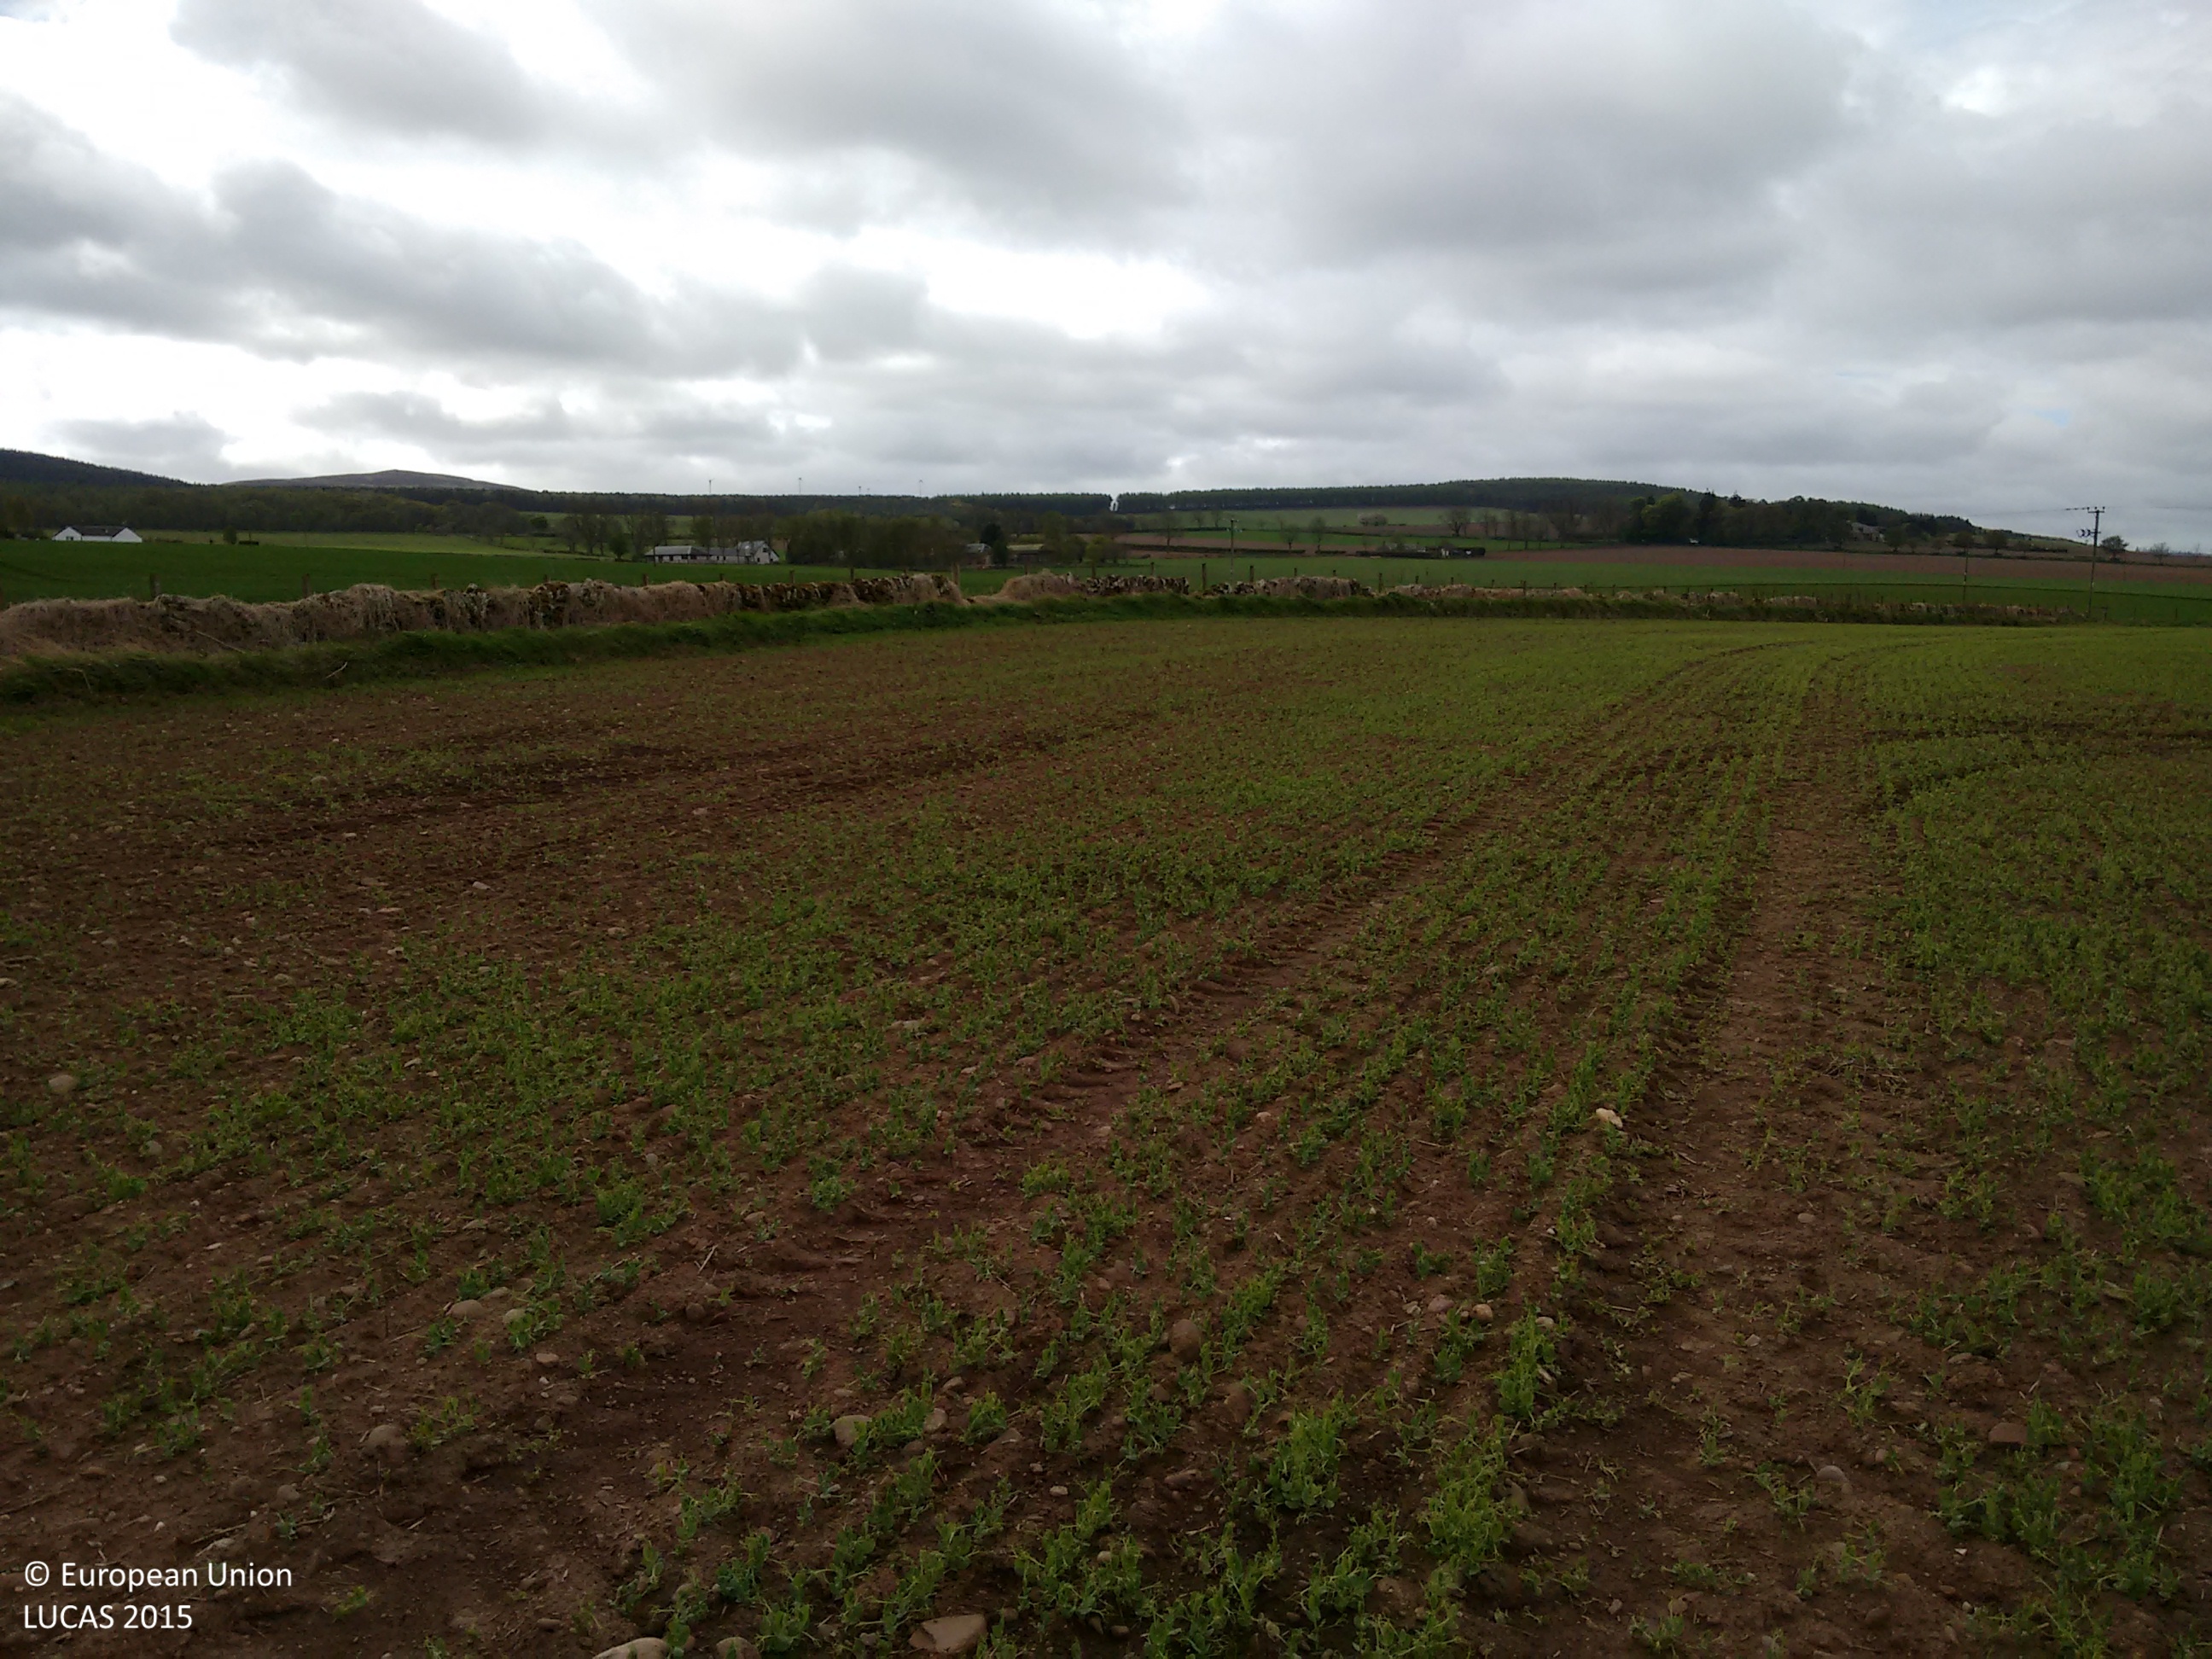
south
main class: Cropland
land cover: Dry pulses
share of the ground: 25 - 50 %
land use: Agriculture (excluding fallow land and kitchen gardens)
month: May
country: GB
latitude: 56.6120
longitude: -3.0521
